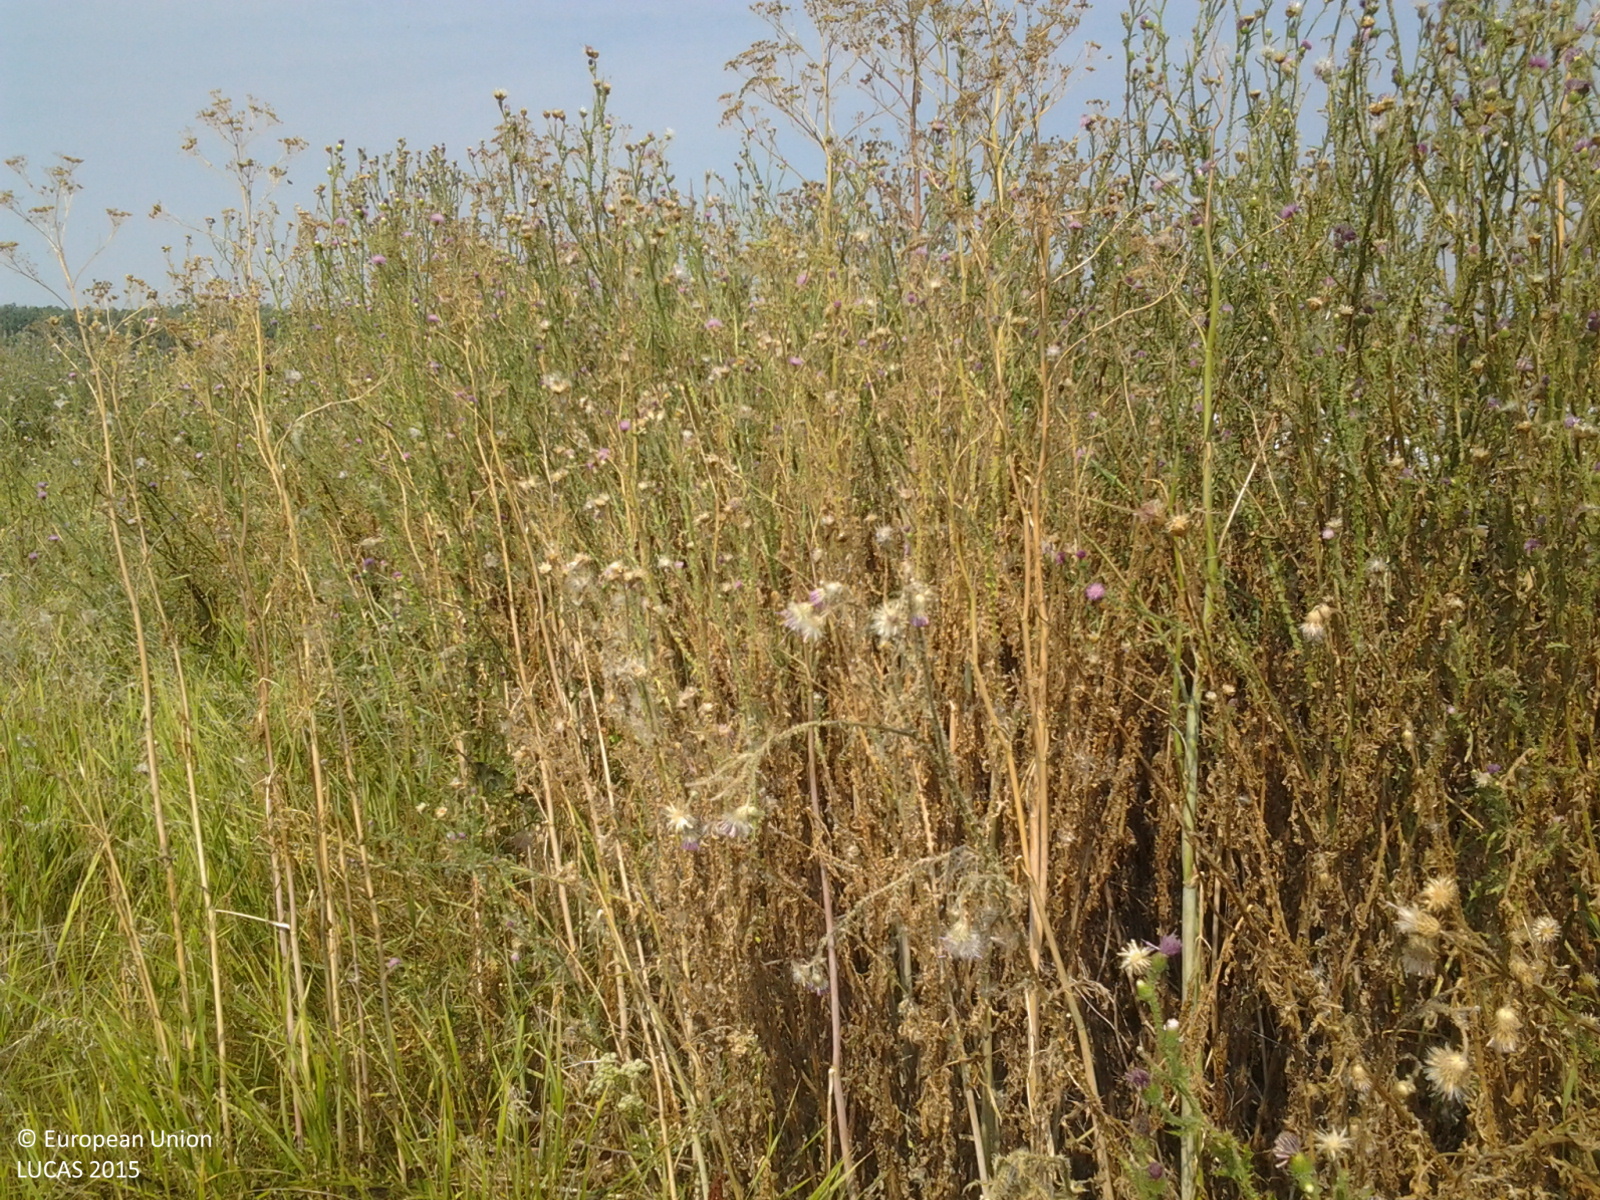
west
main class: Grassland
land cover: Grassland without tree/shrub cover
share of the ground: > 75 %
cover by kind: herbaceous plants 100 %
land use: Agriculture (excluding fallow land and kitchen gardens)
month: July
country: HU
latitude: 46.7916
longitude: 21.4226
